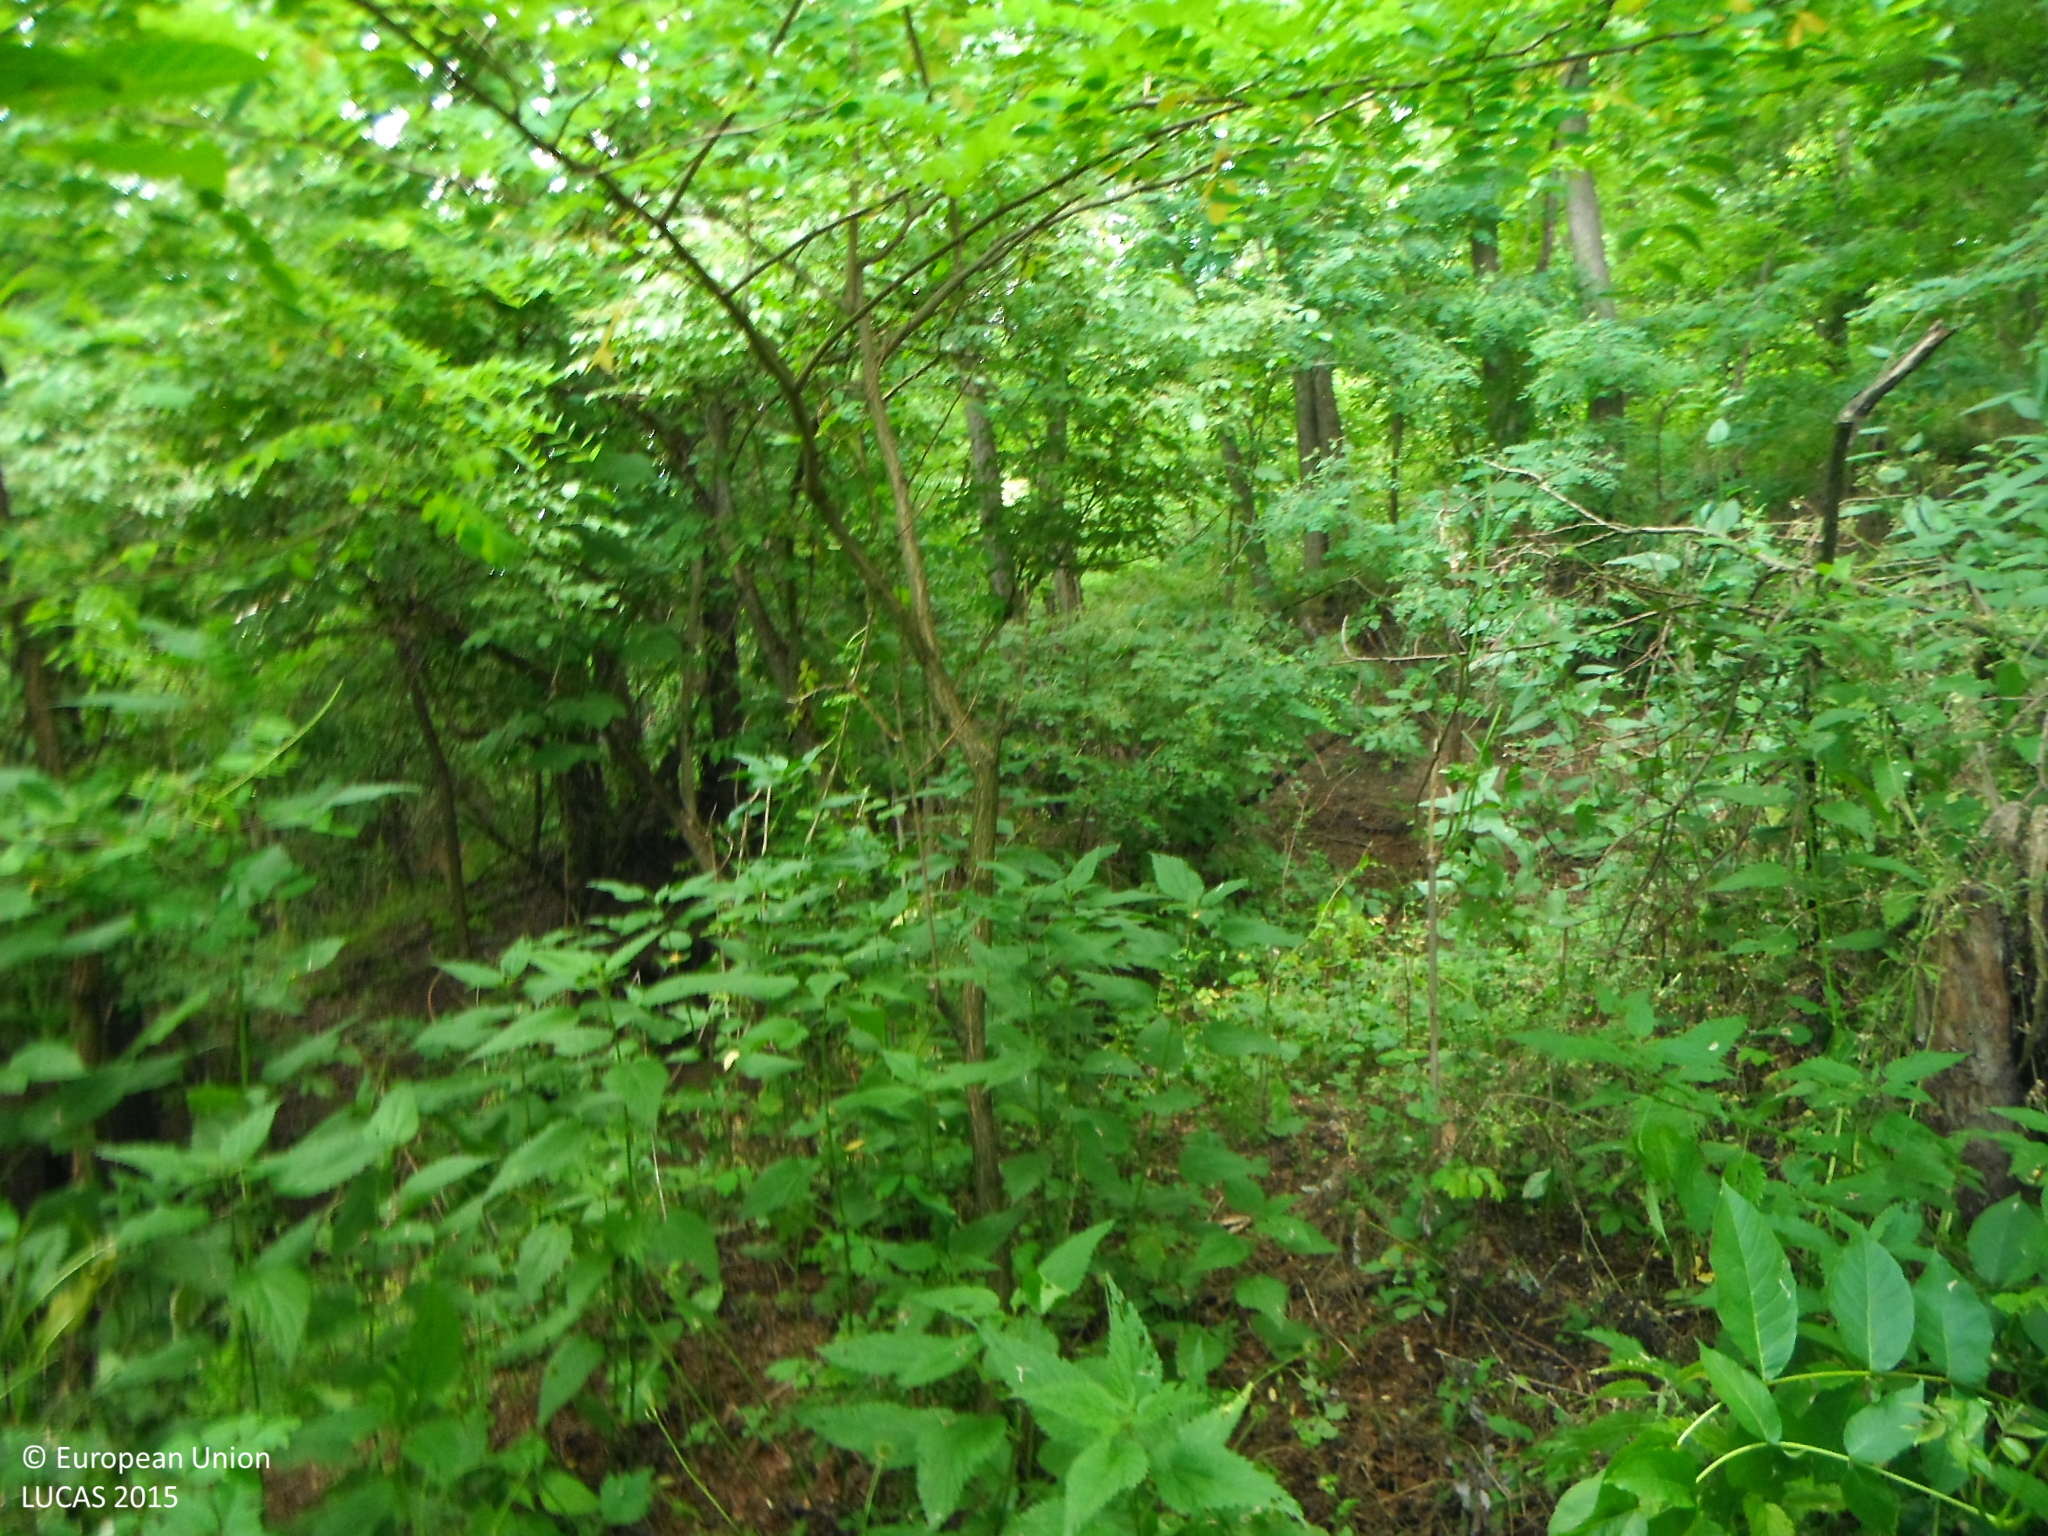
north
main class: Woodland
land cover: Broadleaved woodland
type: mesophytic deciduous forest
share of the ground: > 75 %
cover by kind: broadleaved forest trees 100 %
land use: Forestry
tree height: > 5 m
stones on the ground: < 10 %
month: July
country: SK
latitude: 48.6505
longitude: 20.0617
